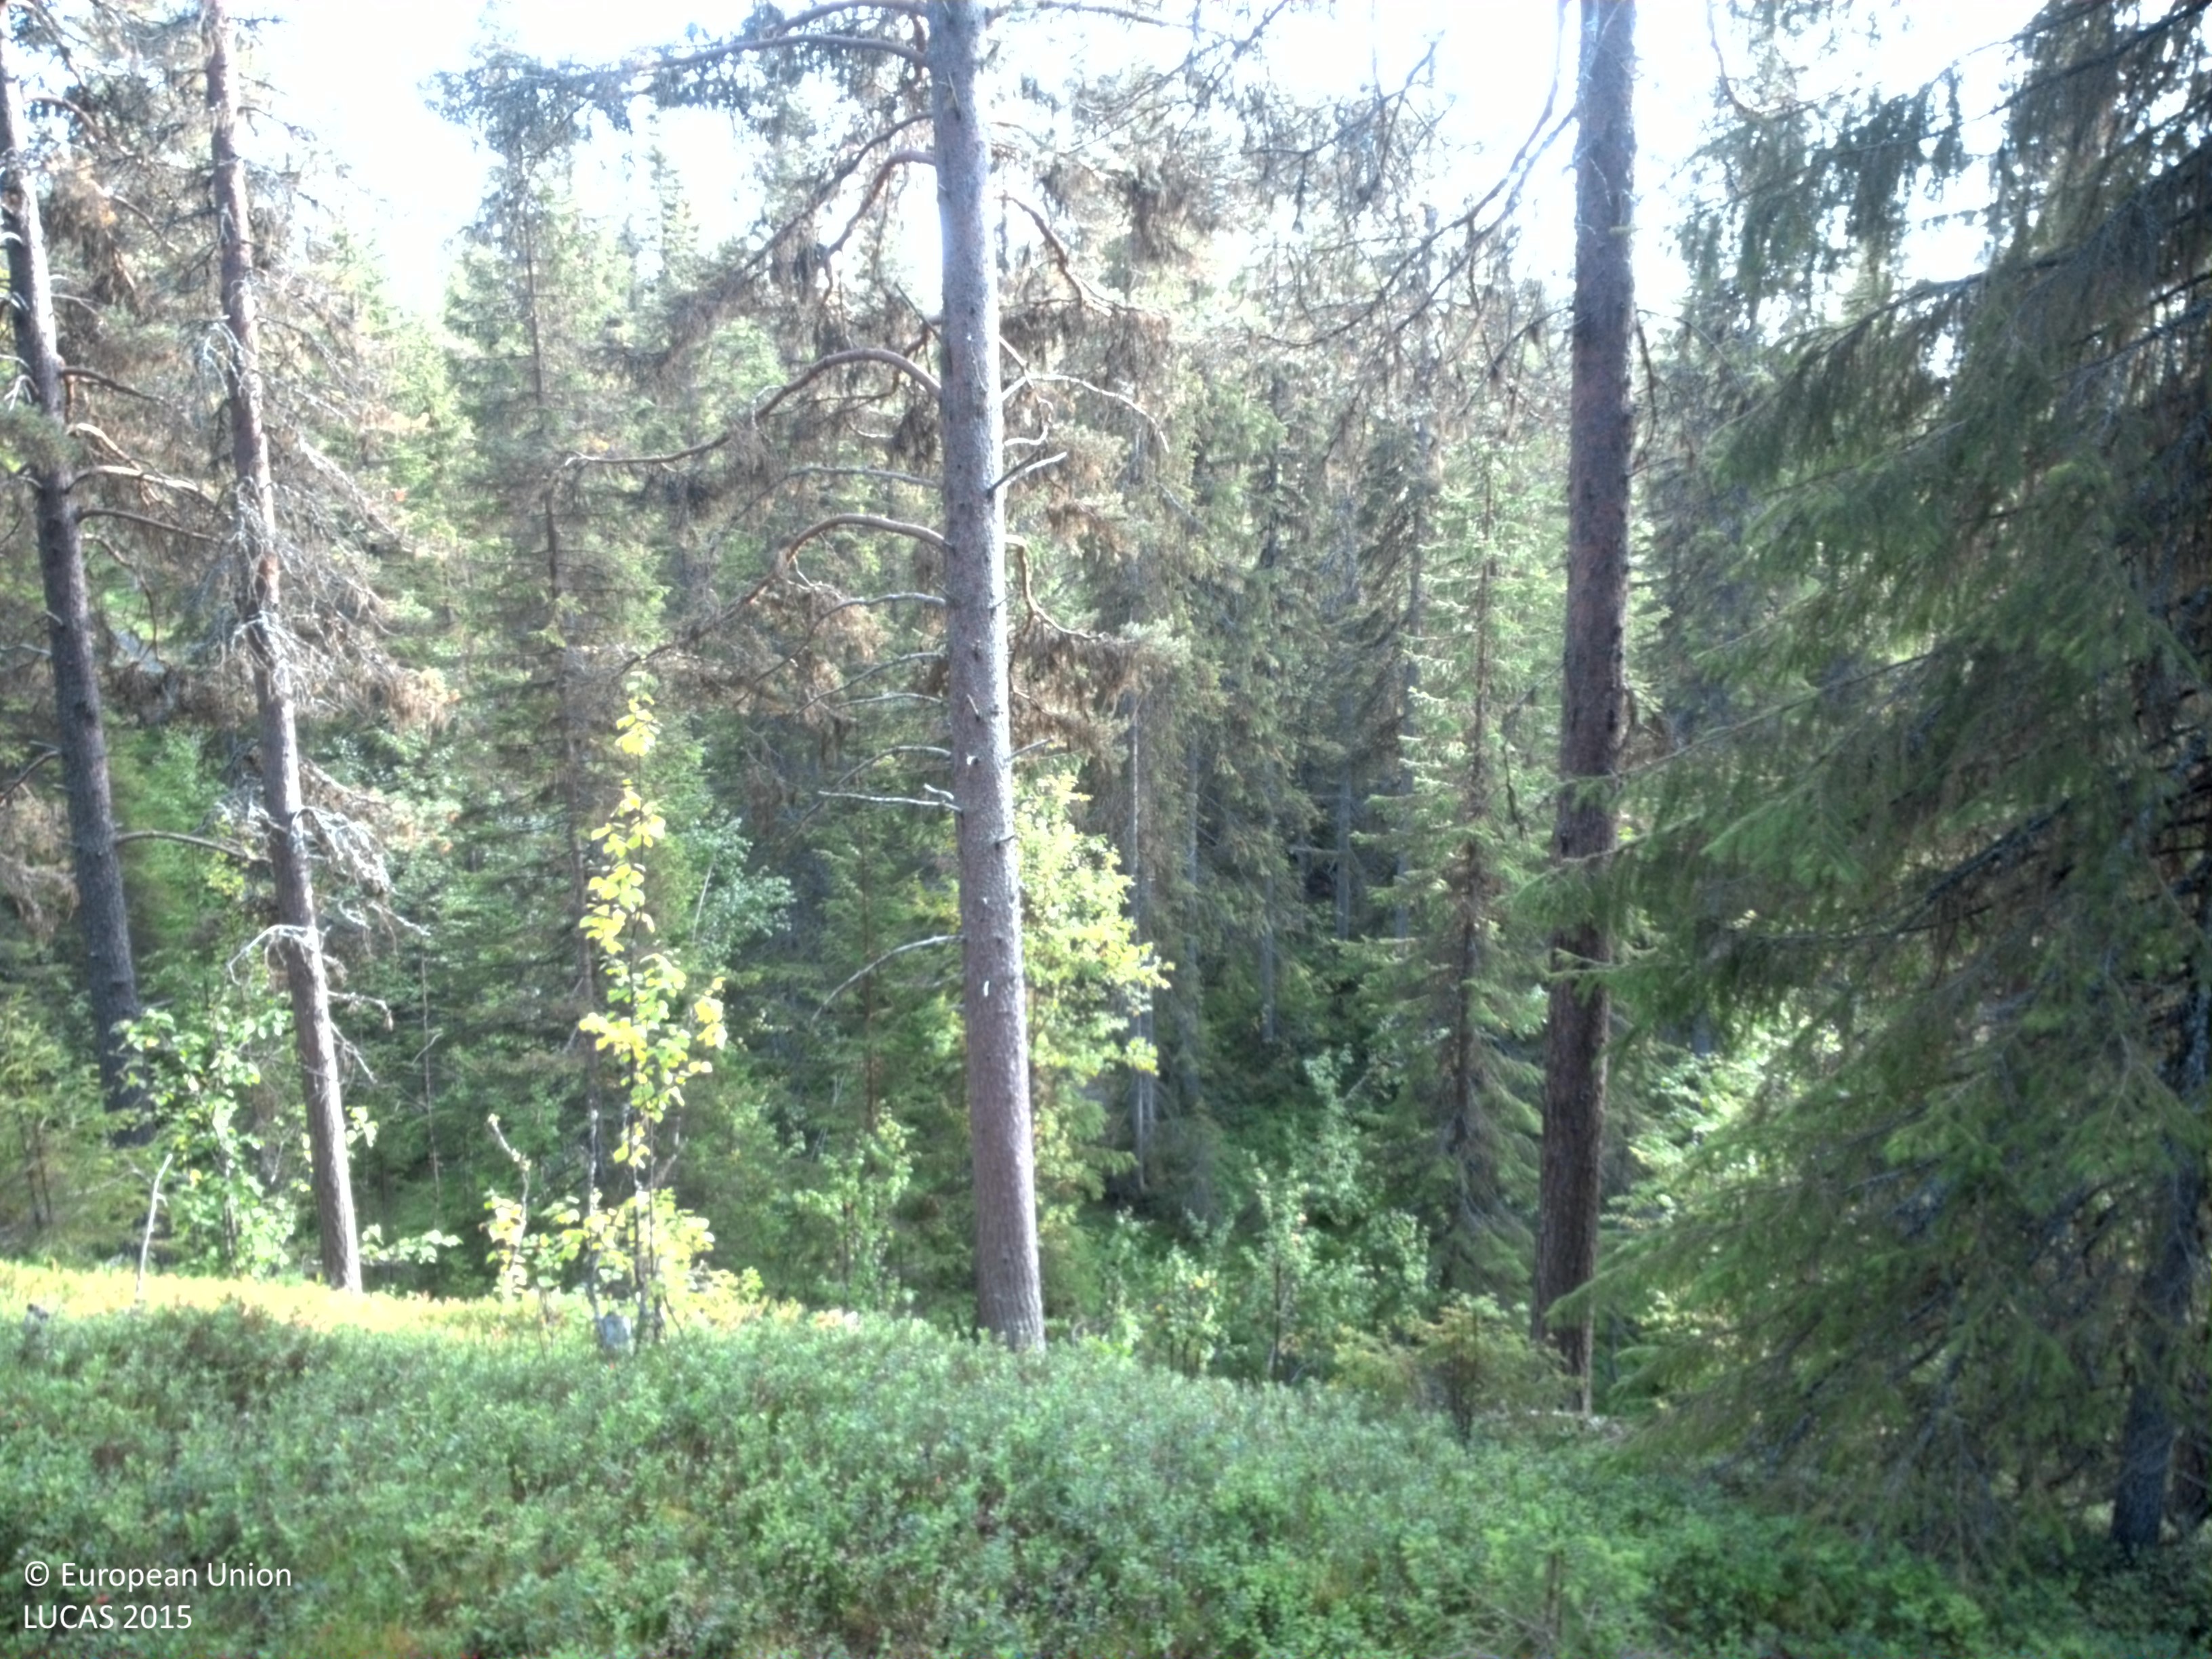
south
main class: Woodland
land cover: Other coniferous woodland
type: boreal forest
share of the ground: 25 - 50 %
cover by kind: coniferous forest trees 35 %, shrubs 35 %, lichens and mosses 20 %, broadleaved forest trees 5 %, herbaceous plants 5 %
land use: Forestry
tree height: > 5 m
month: September
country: SE
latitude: 65.3849
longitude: 16.6106
